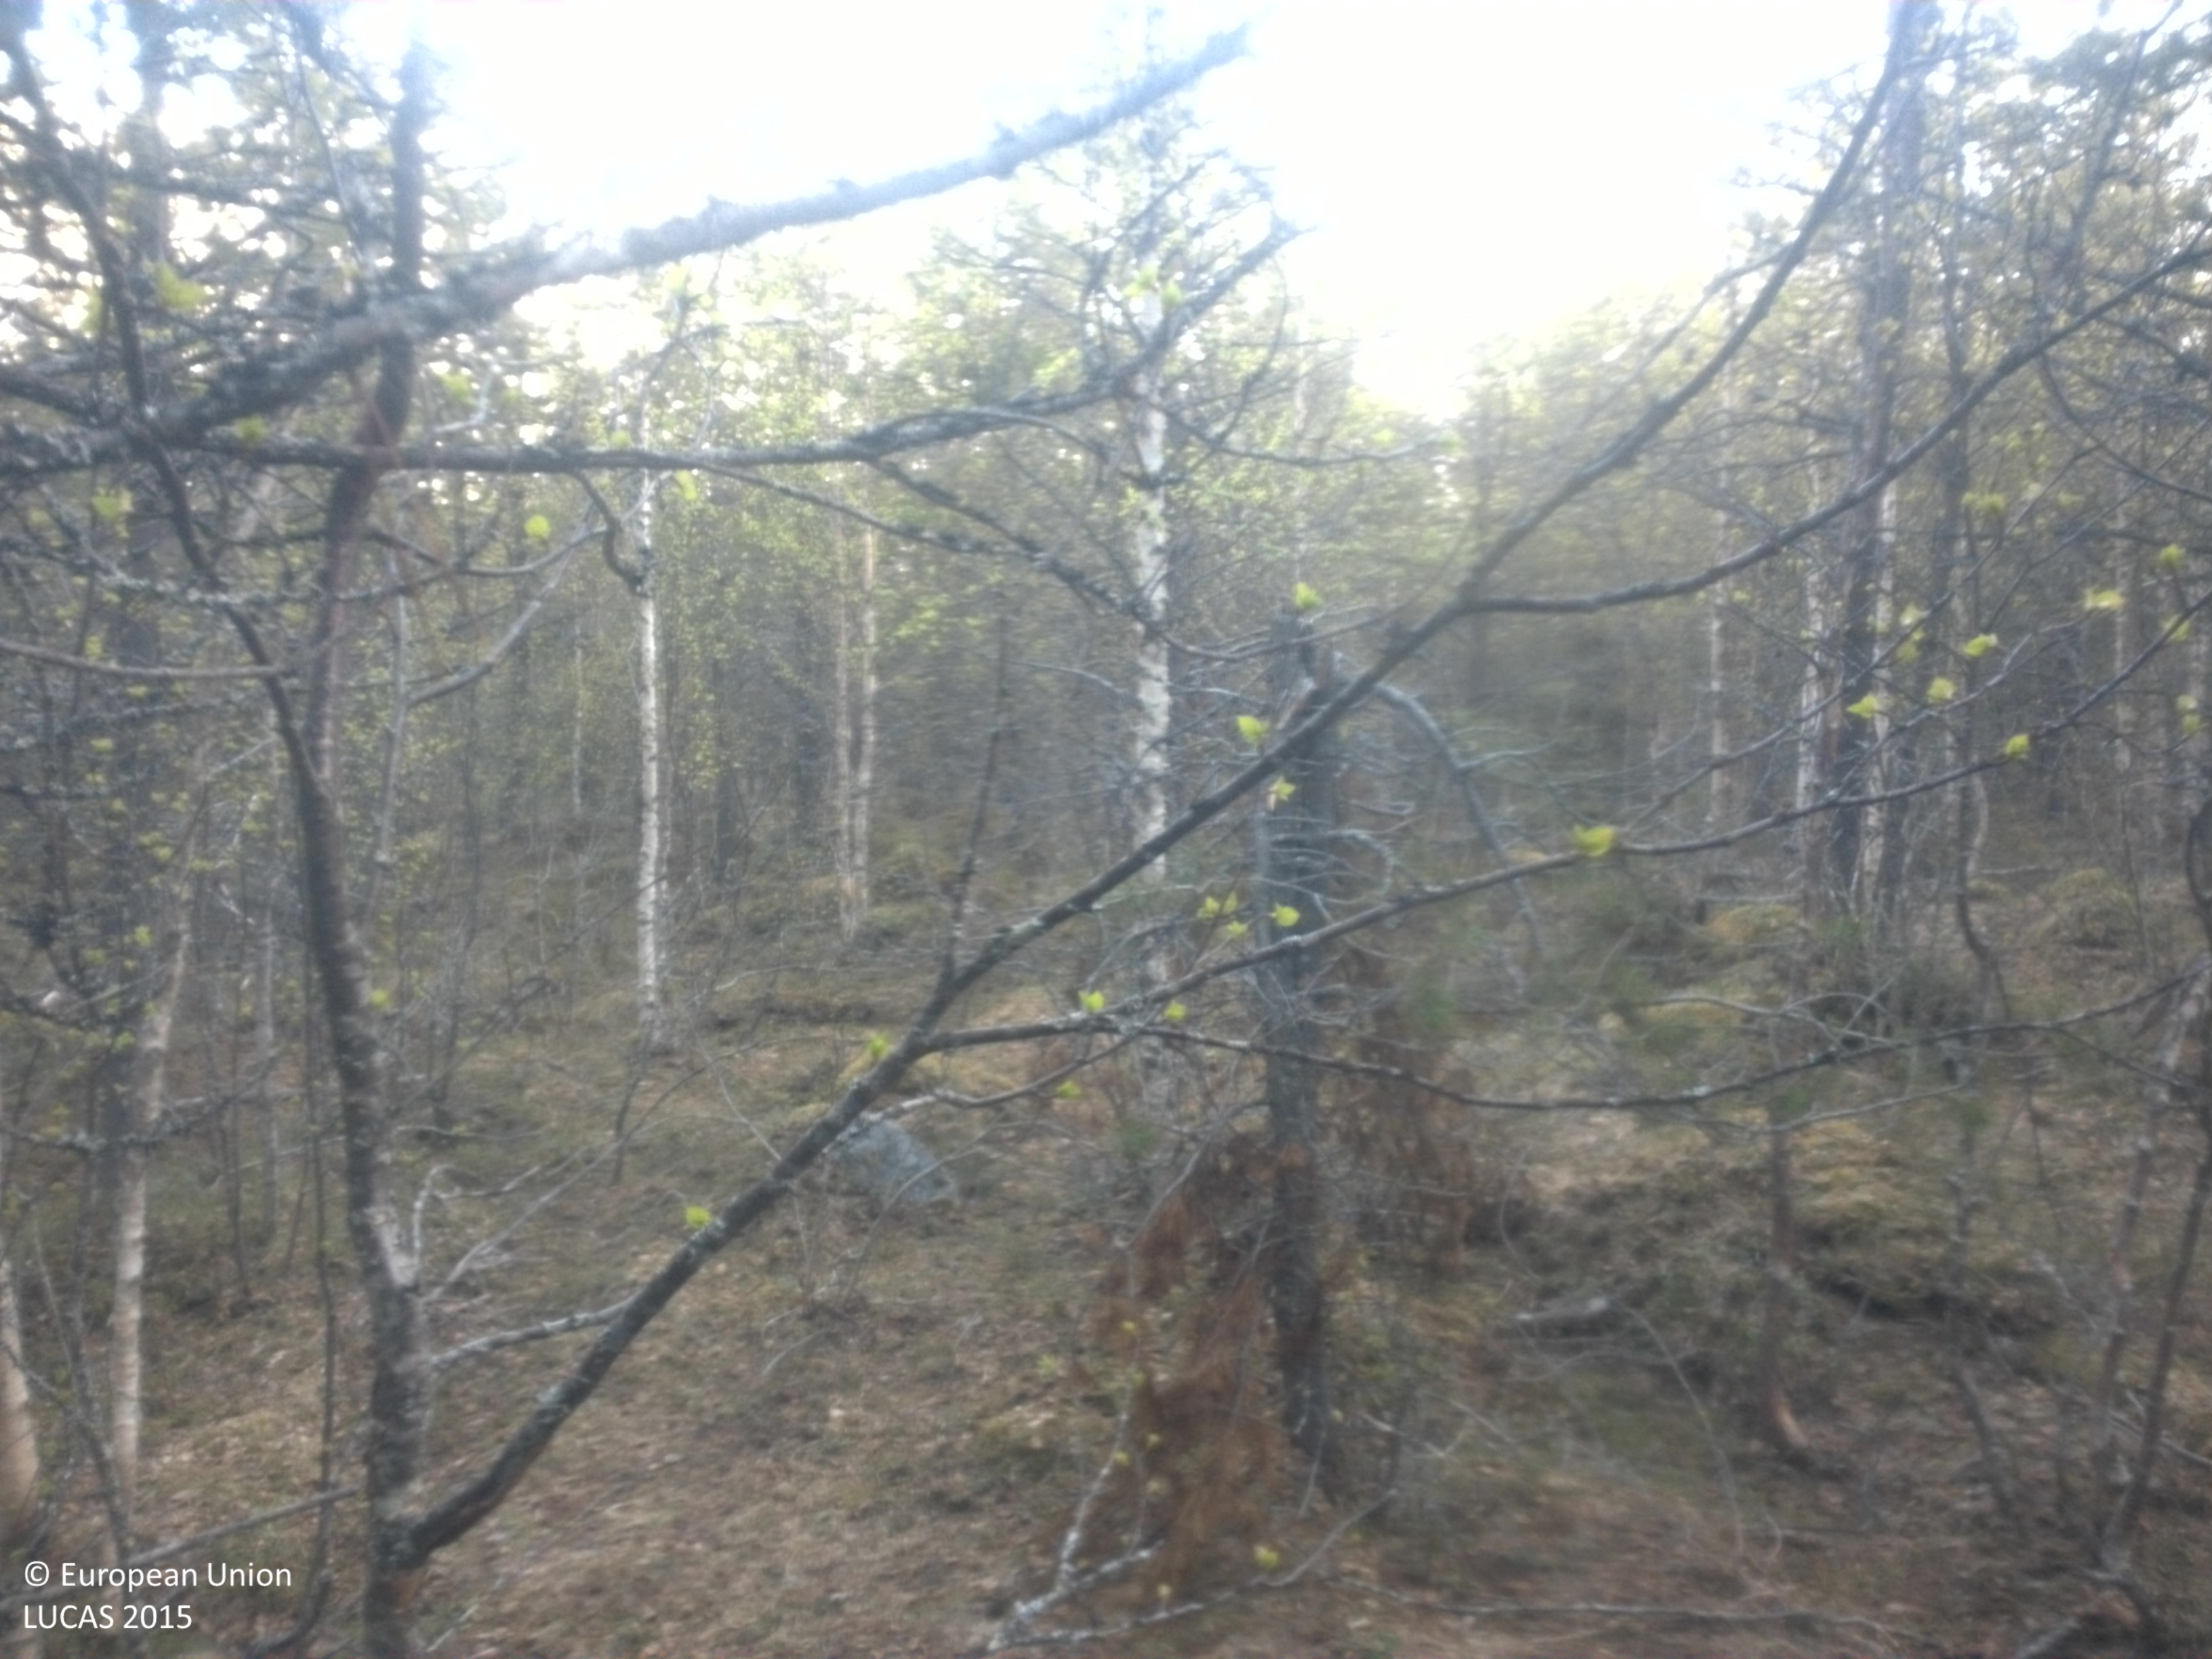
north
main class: Woodland
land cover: Pine dominated mixed woodland
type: exotic forest
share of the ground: 50 - 75 %
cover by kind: coniferous forest trees 45 %, herbaceous plants 20 %, broadleaved forest trees 15 %, lichens and mosses 10 %, shrubs 5 %, unconsolidated bare surface 5 %
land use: Forestry
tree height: > 5 m
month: June
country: SE
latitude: 64.4981
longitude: 17.7737
